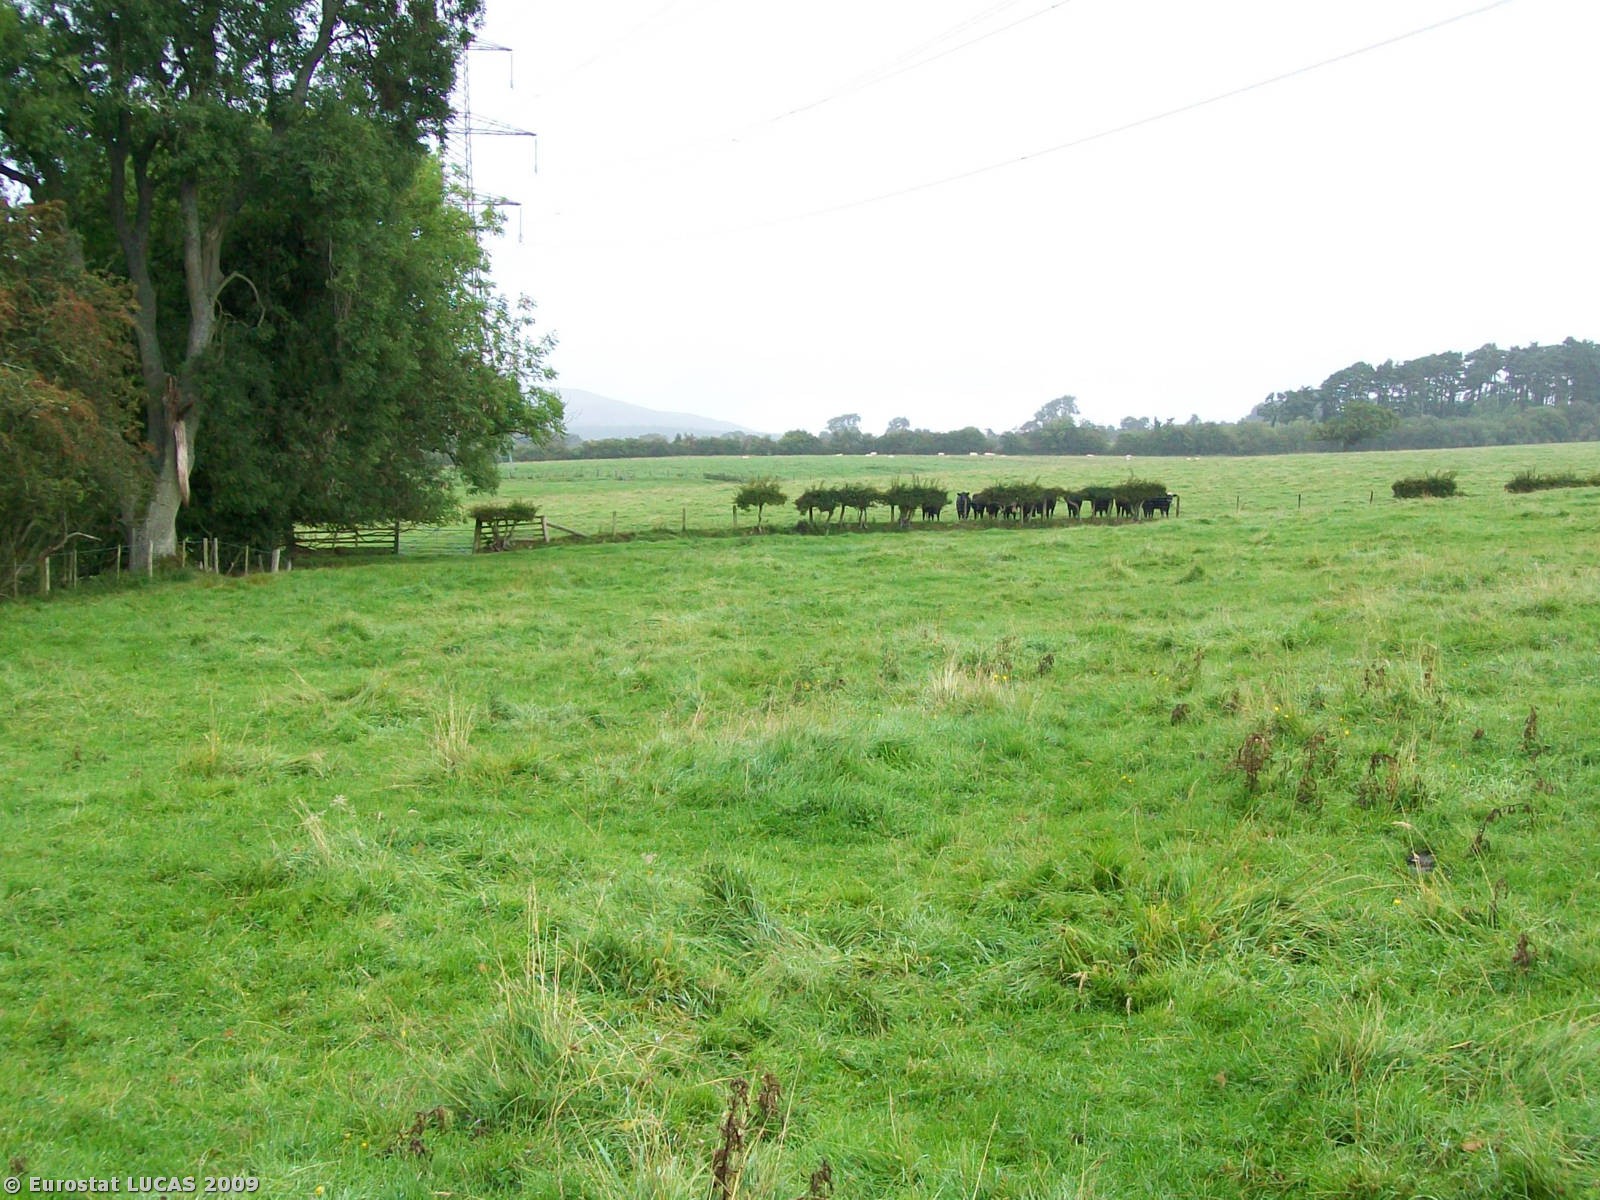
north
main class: Grassland
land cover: Grassland without tree/shrub cover
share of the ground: > 75 %
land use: Agriculture (excluding fallow land and kitchen gardens)
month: September
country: GB
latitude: 55.2940
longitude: -1.8151
